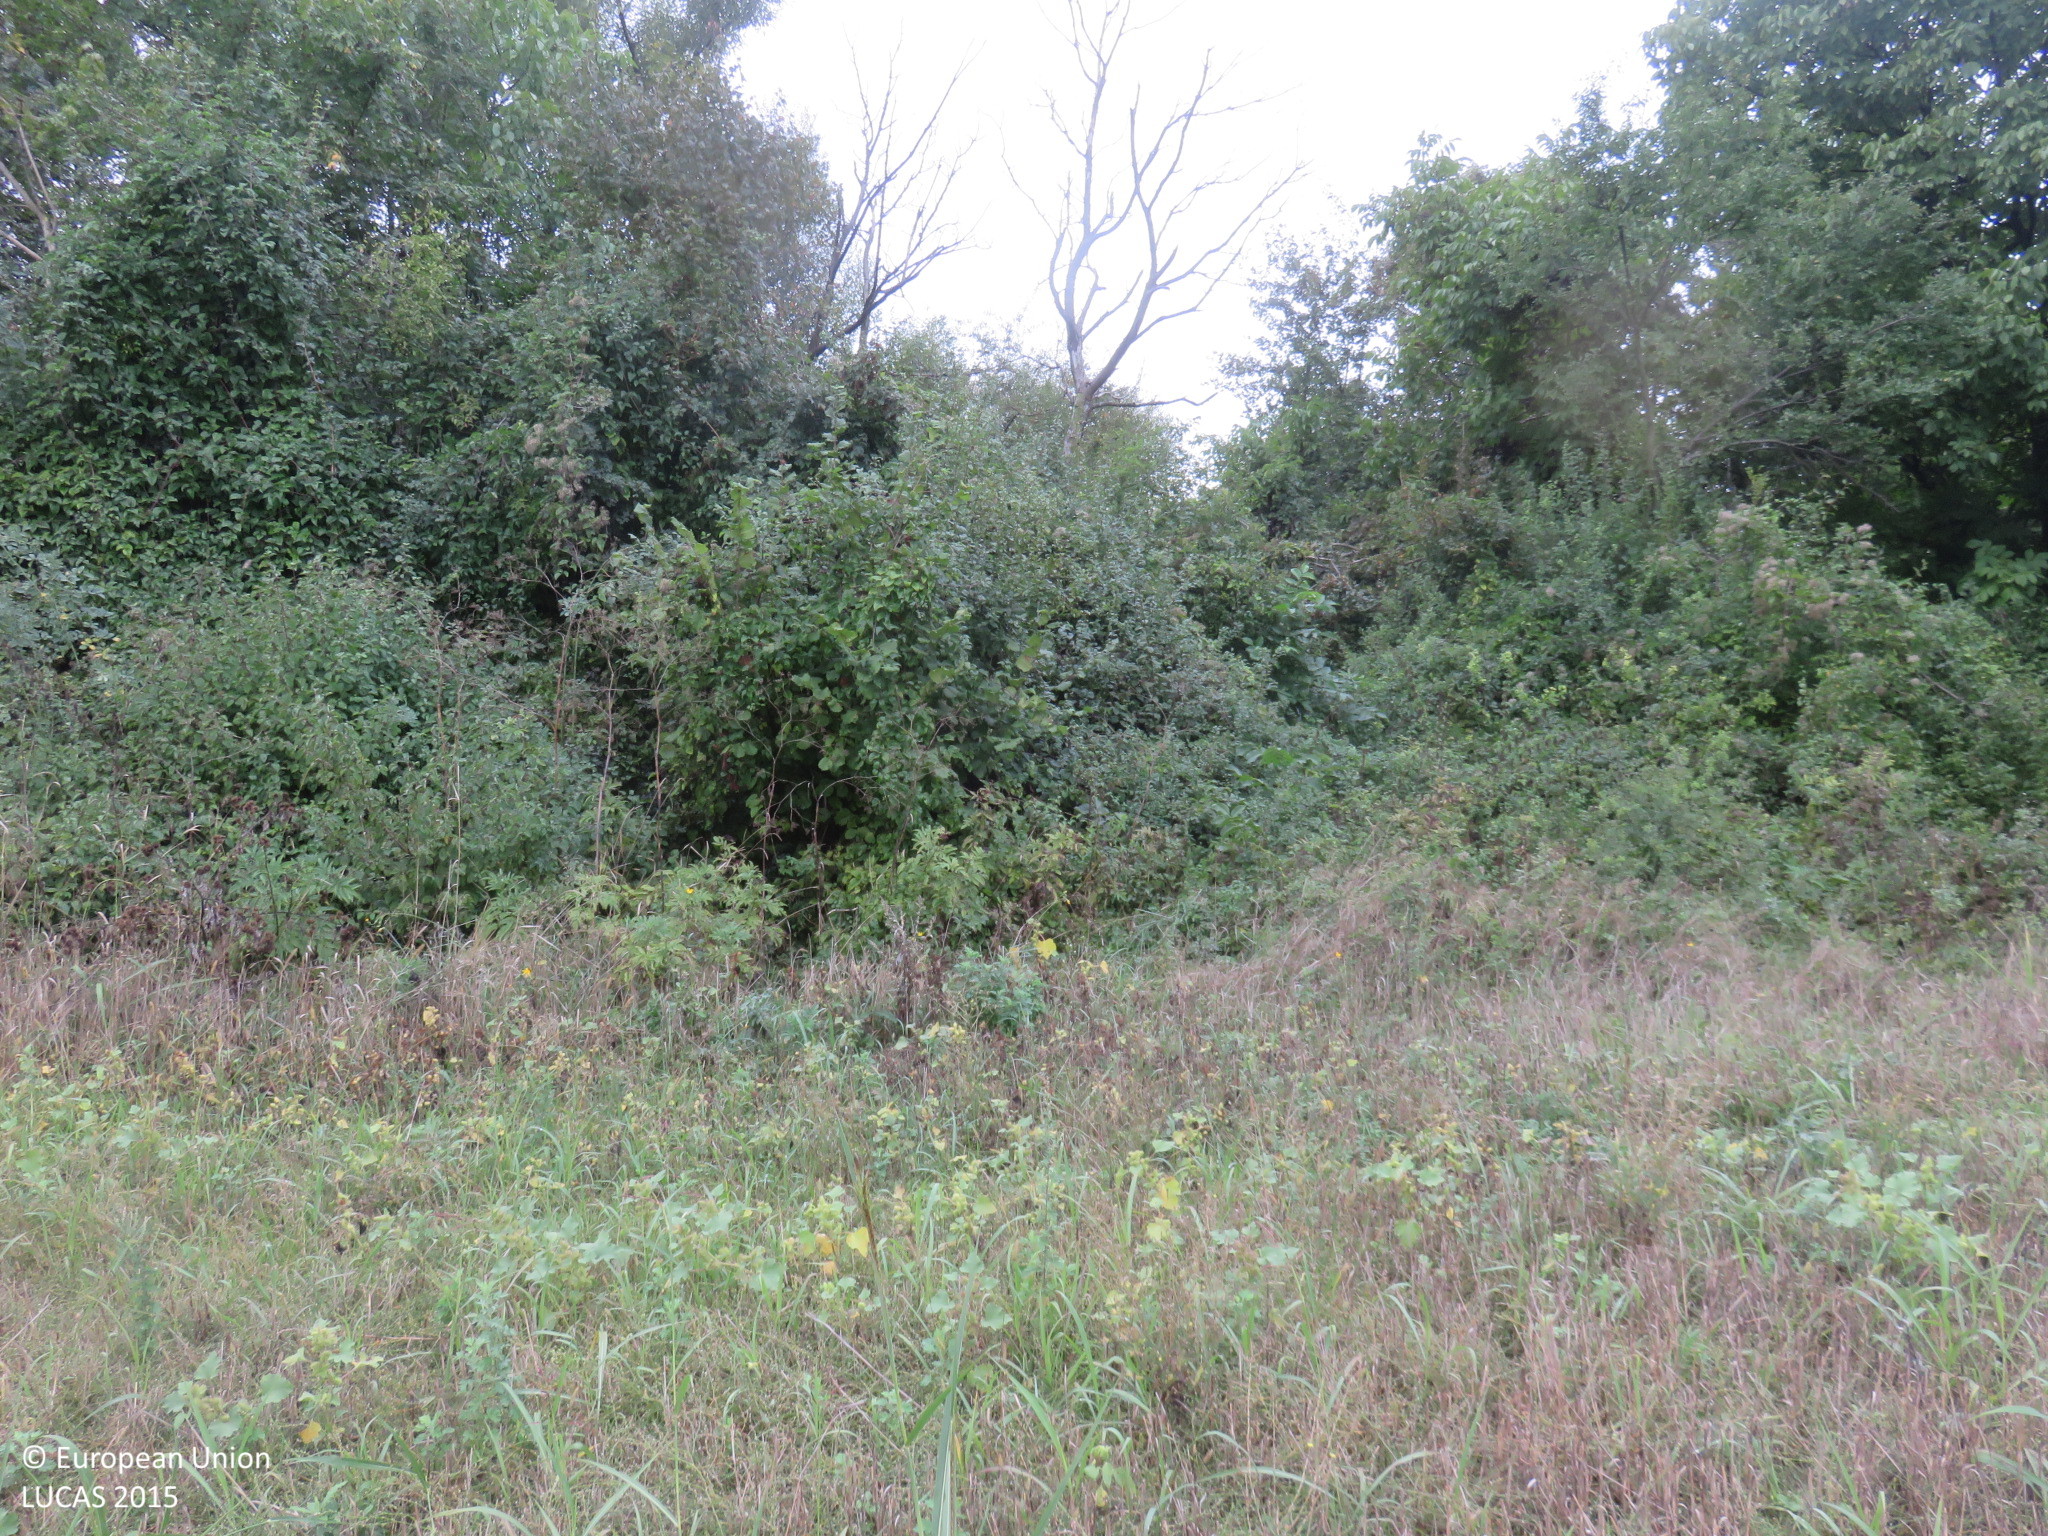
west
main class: Cropland
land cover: Common wheat
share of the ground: < 10 %
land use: Agriculture (excluding fallow land and kitchen gardens)
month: September
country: BG
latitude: 42.9975
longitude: 24.8686
